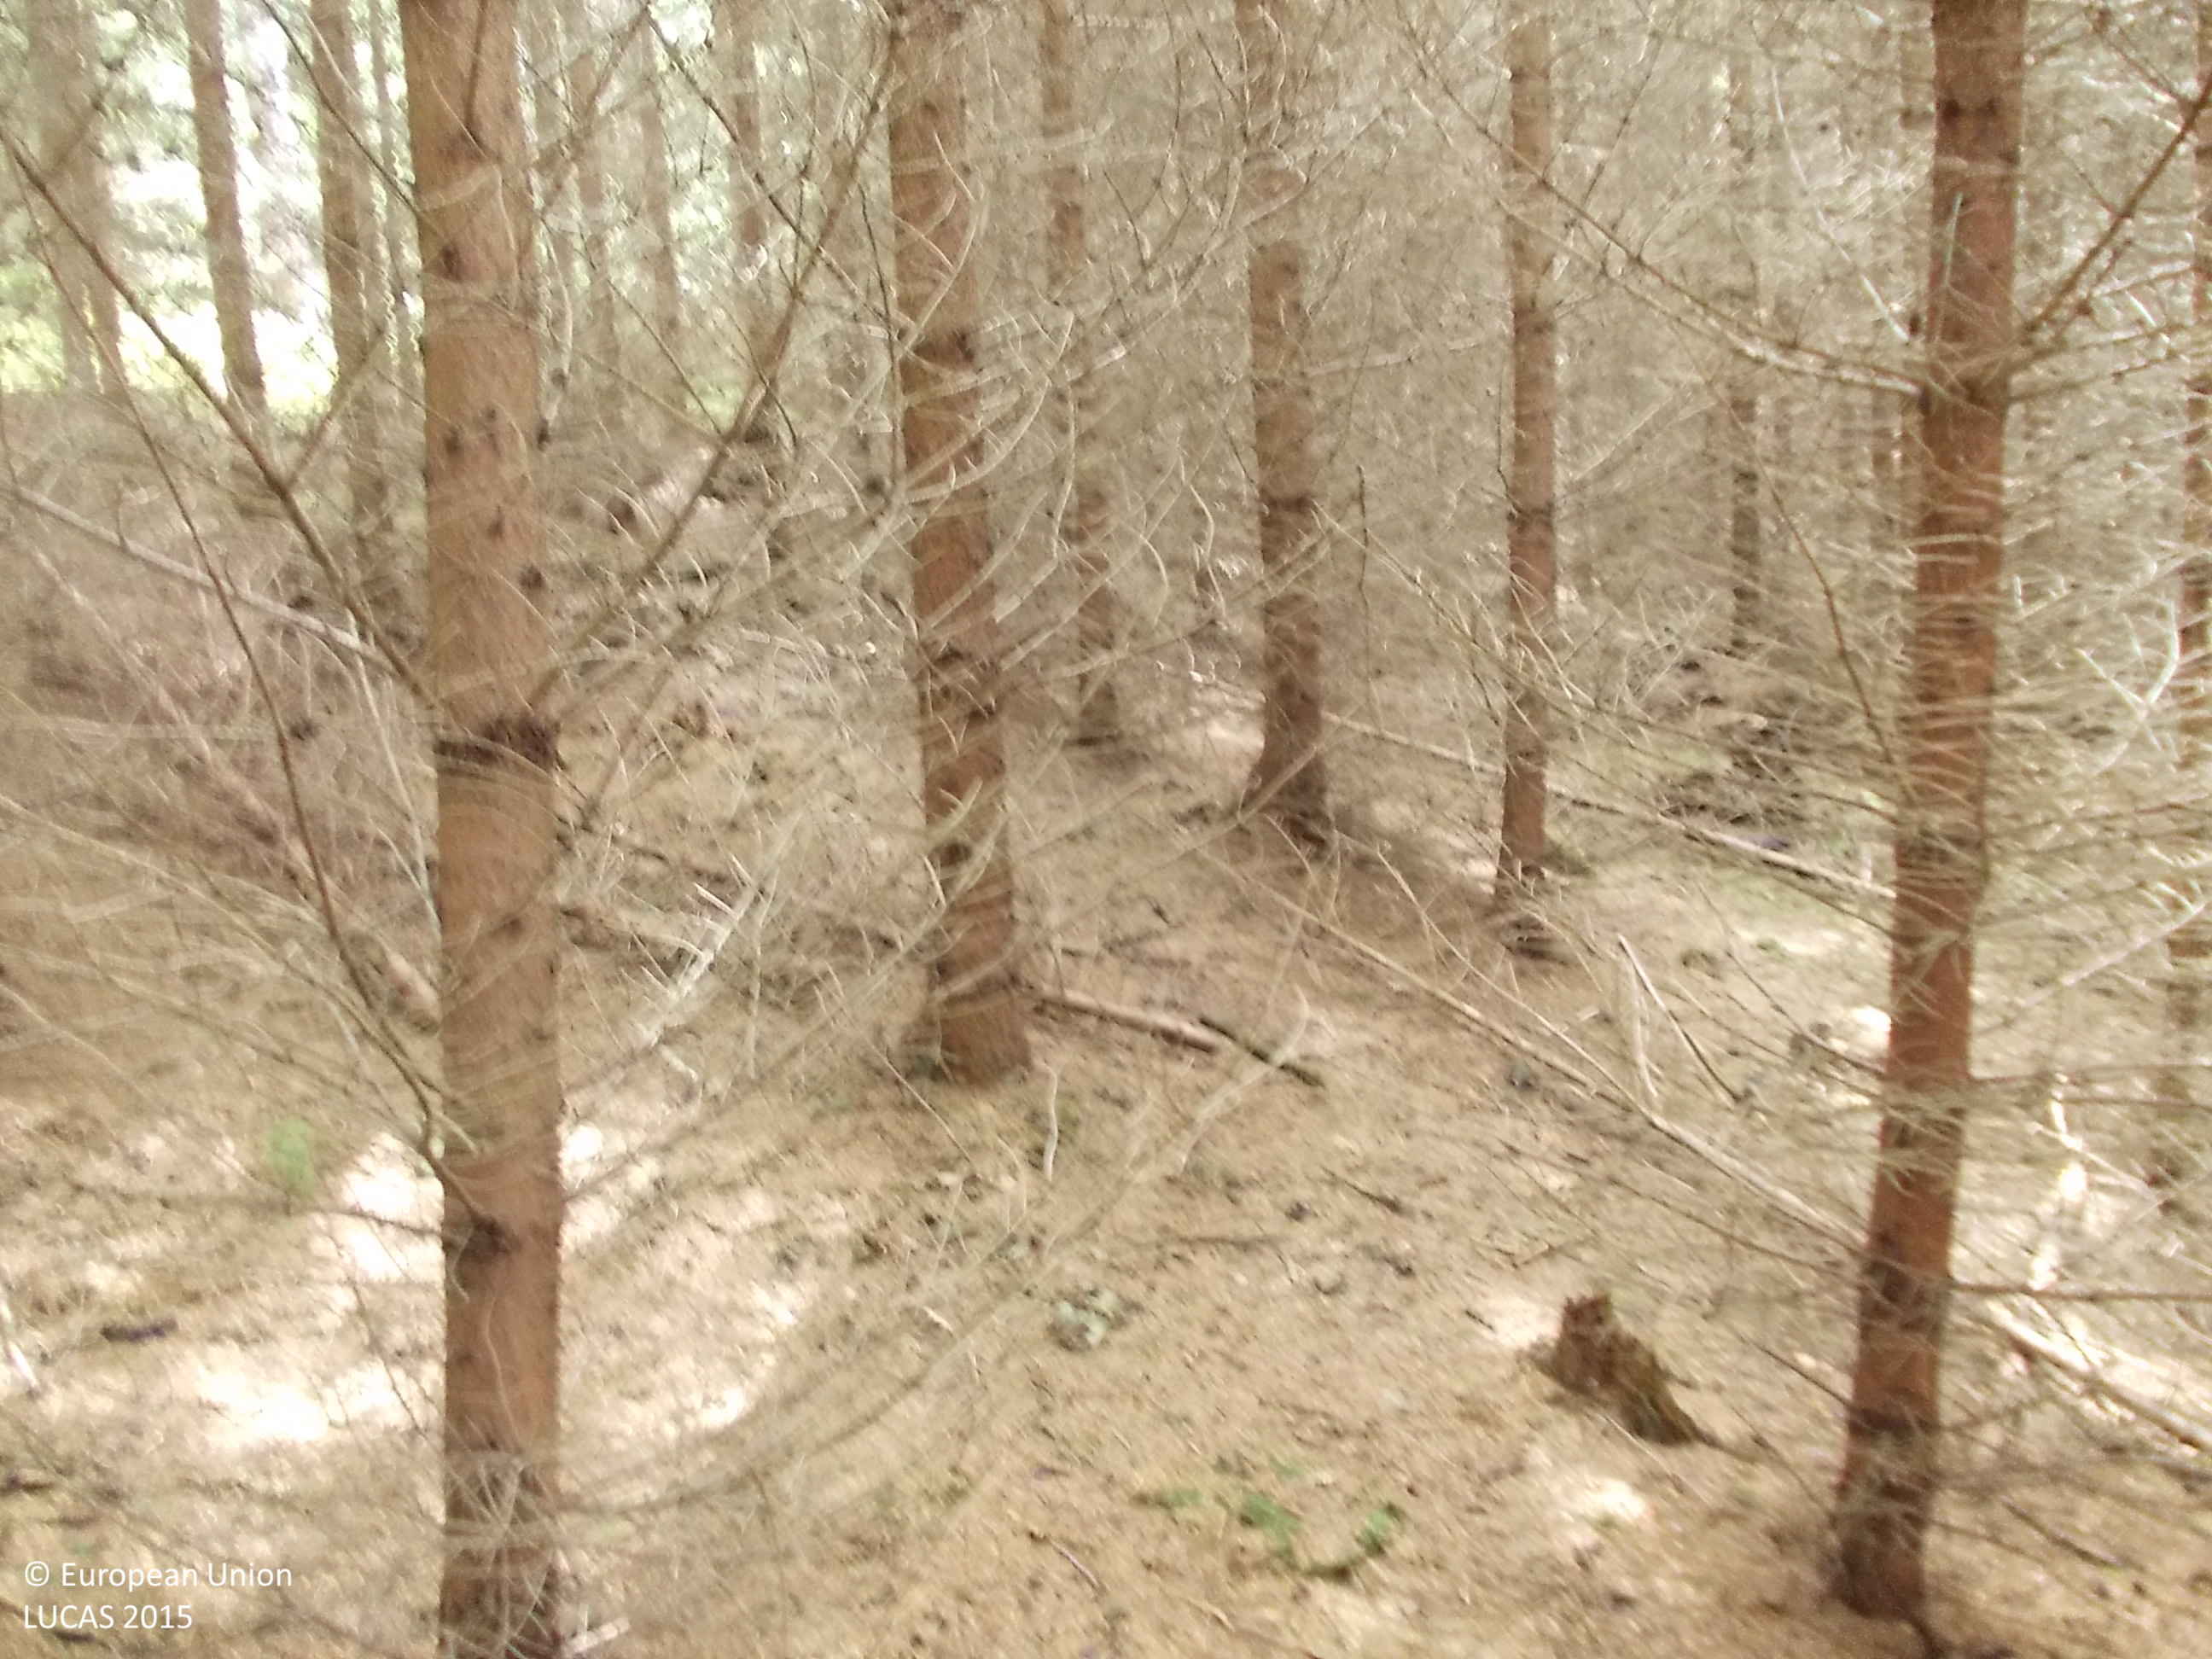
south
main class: Woodland
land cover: Spruce dominated coniferous woodland
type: hemiboreal forest and nemoral coniferous forest and mixed broadleaved-coniferous forest
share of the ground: > 75 %
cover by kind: coniferous forest trees 100 %
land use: Forestry
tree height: > 5 m
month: May
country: CZ
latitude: 49.2395
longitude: 13.7774
